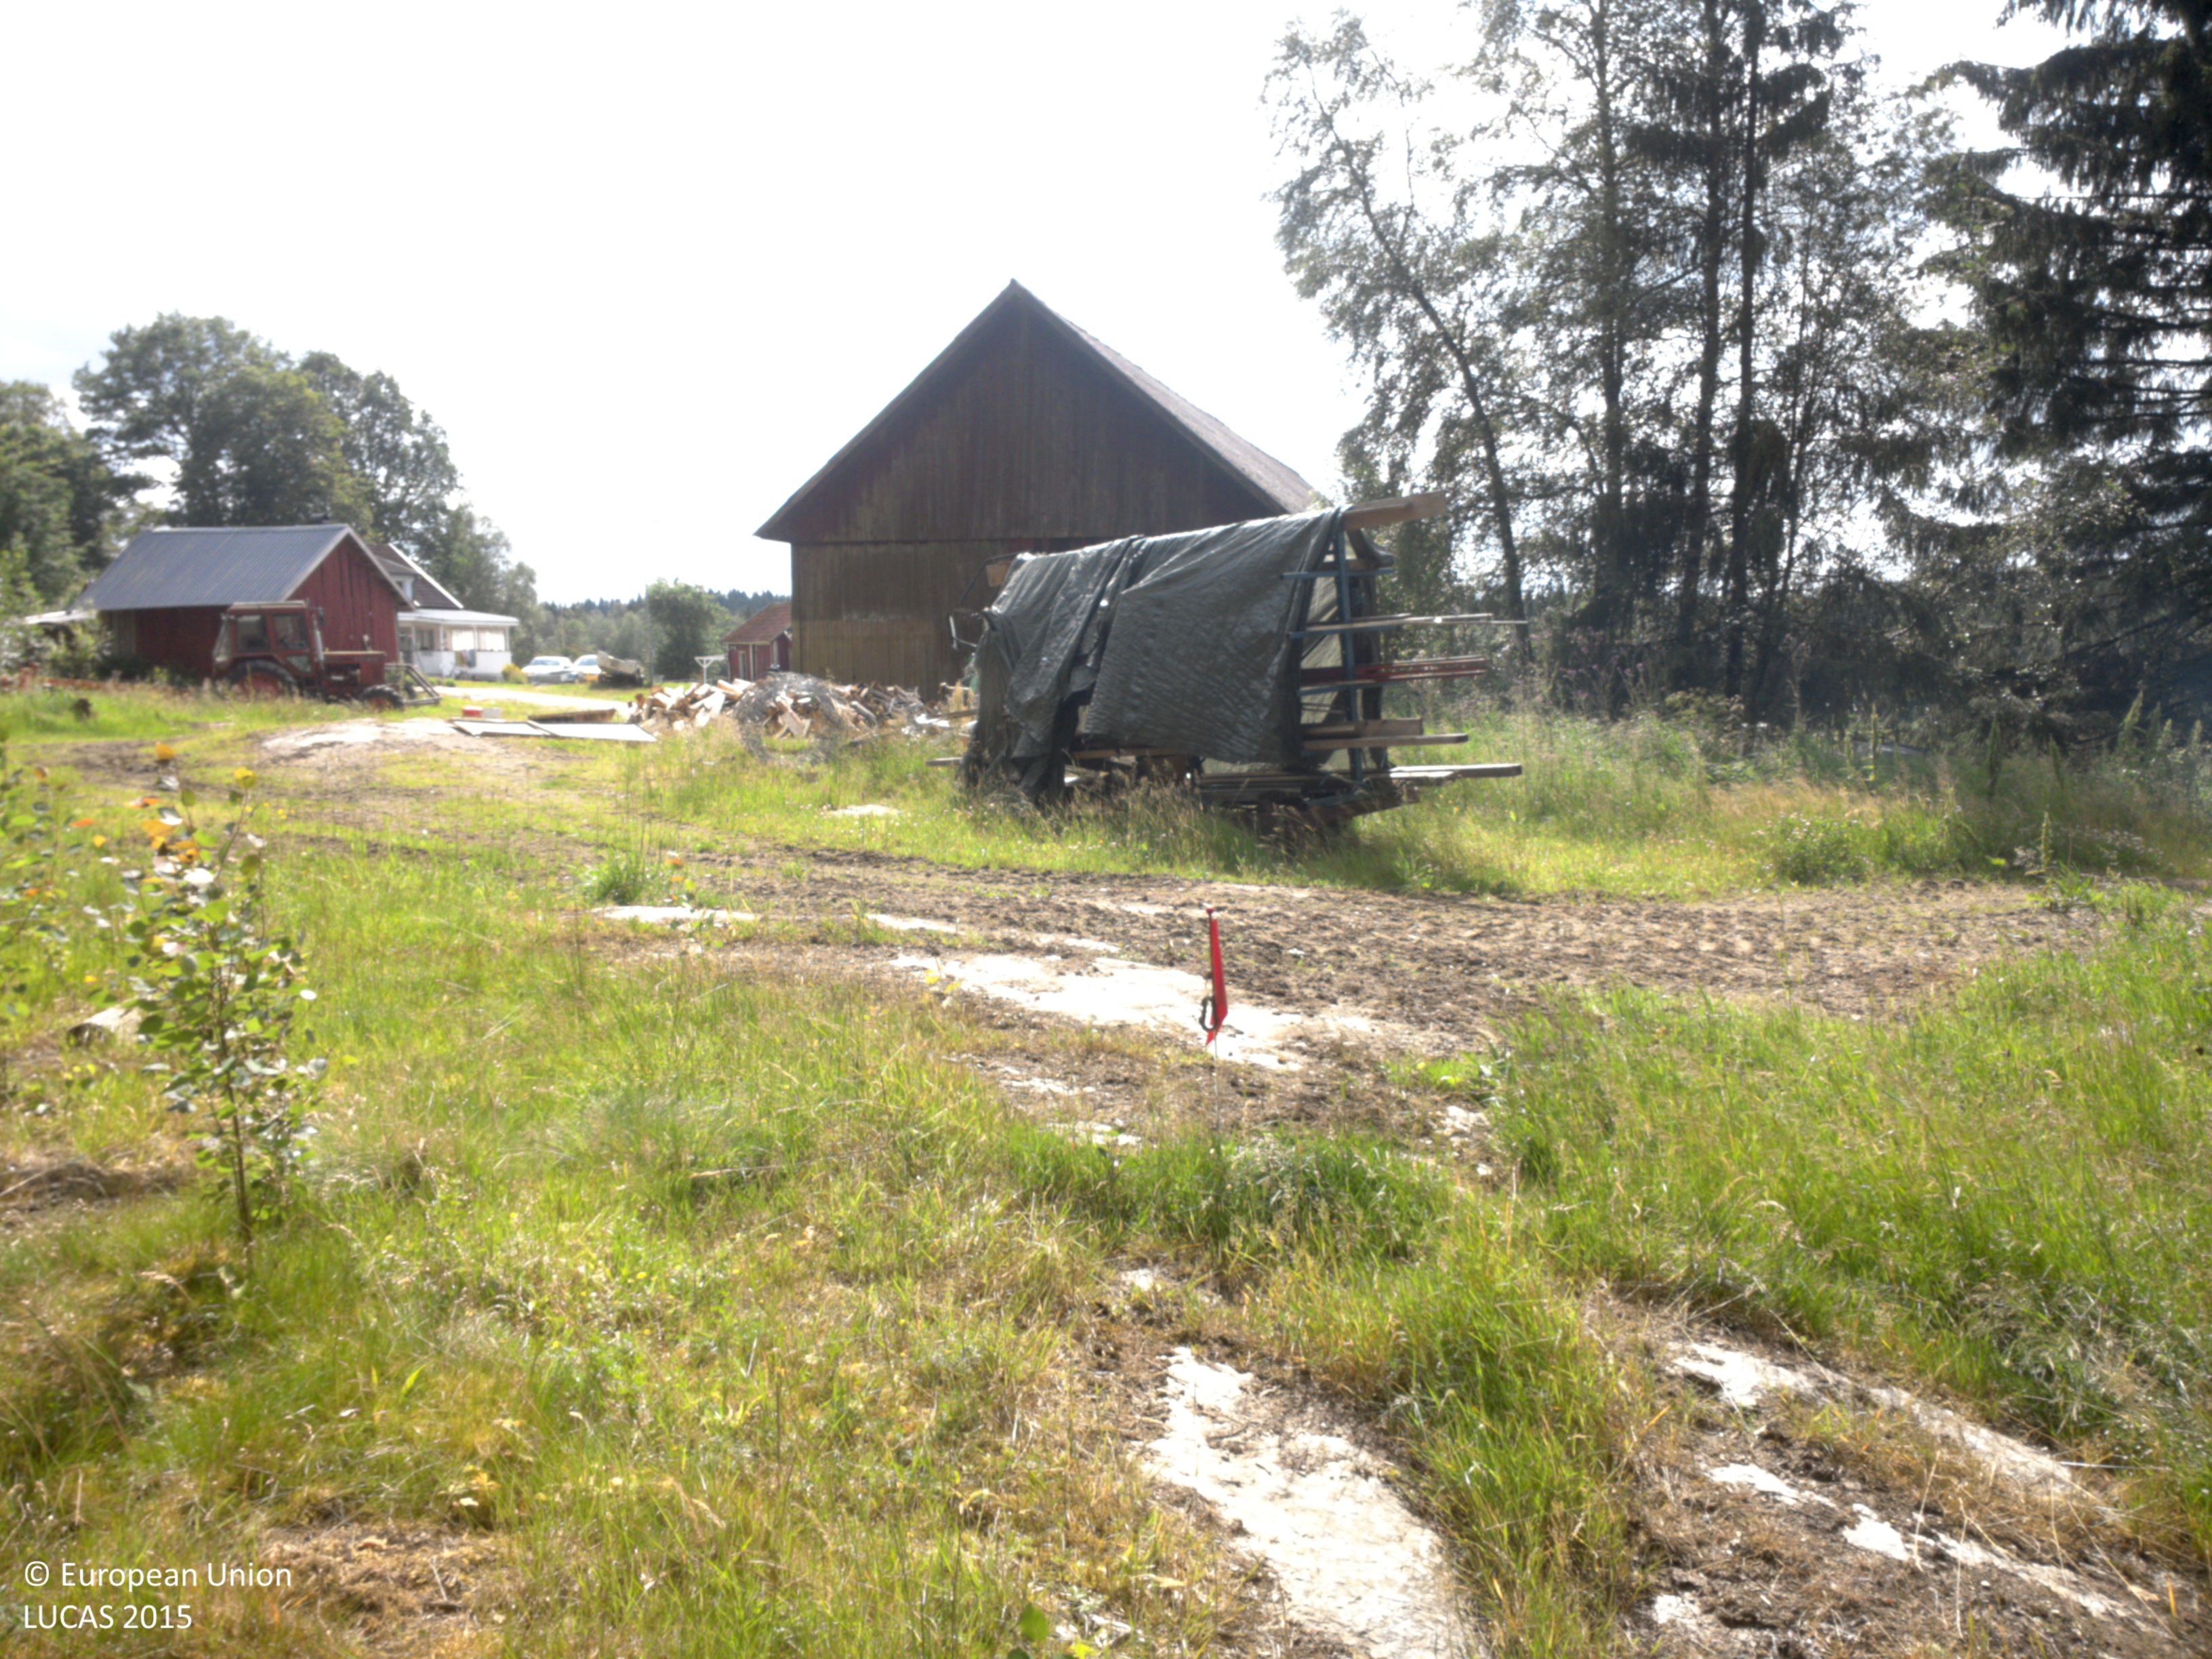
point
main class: Grassland
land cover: Grassland without tree/shrub cover
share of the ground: 50 - 75 %
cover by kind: herbaceous plants 65 %, unconsolidated bare surface 20 %, consolidated bare surface 15 %
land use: Residential
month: July
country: SE
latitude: 58.7801
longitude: 12.0193
